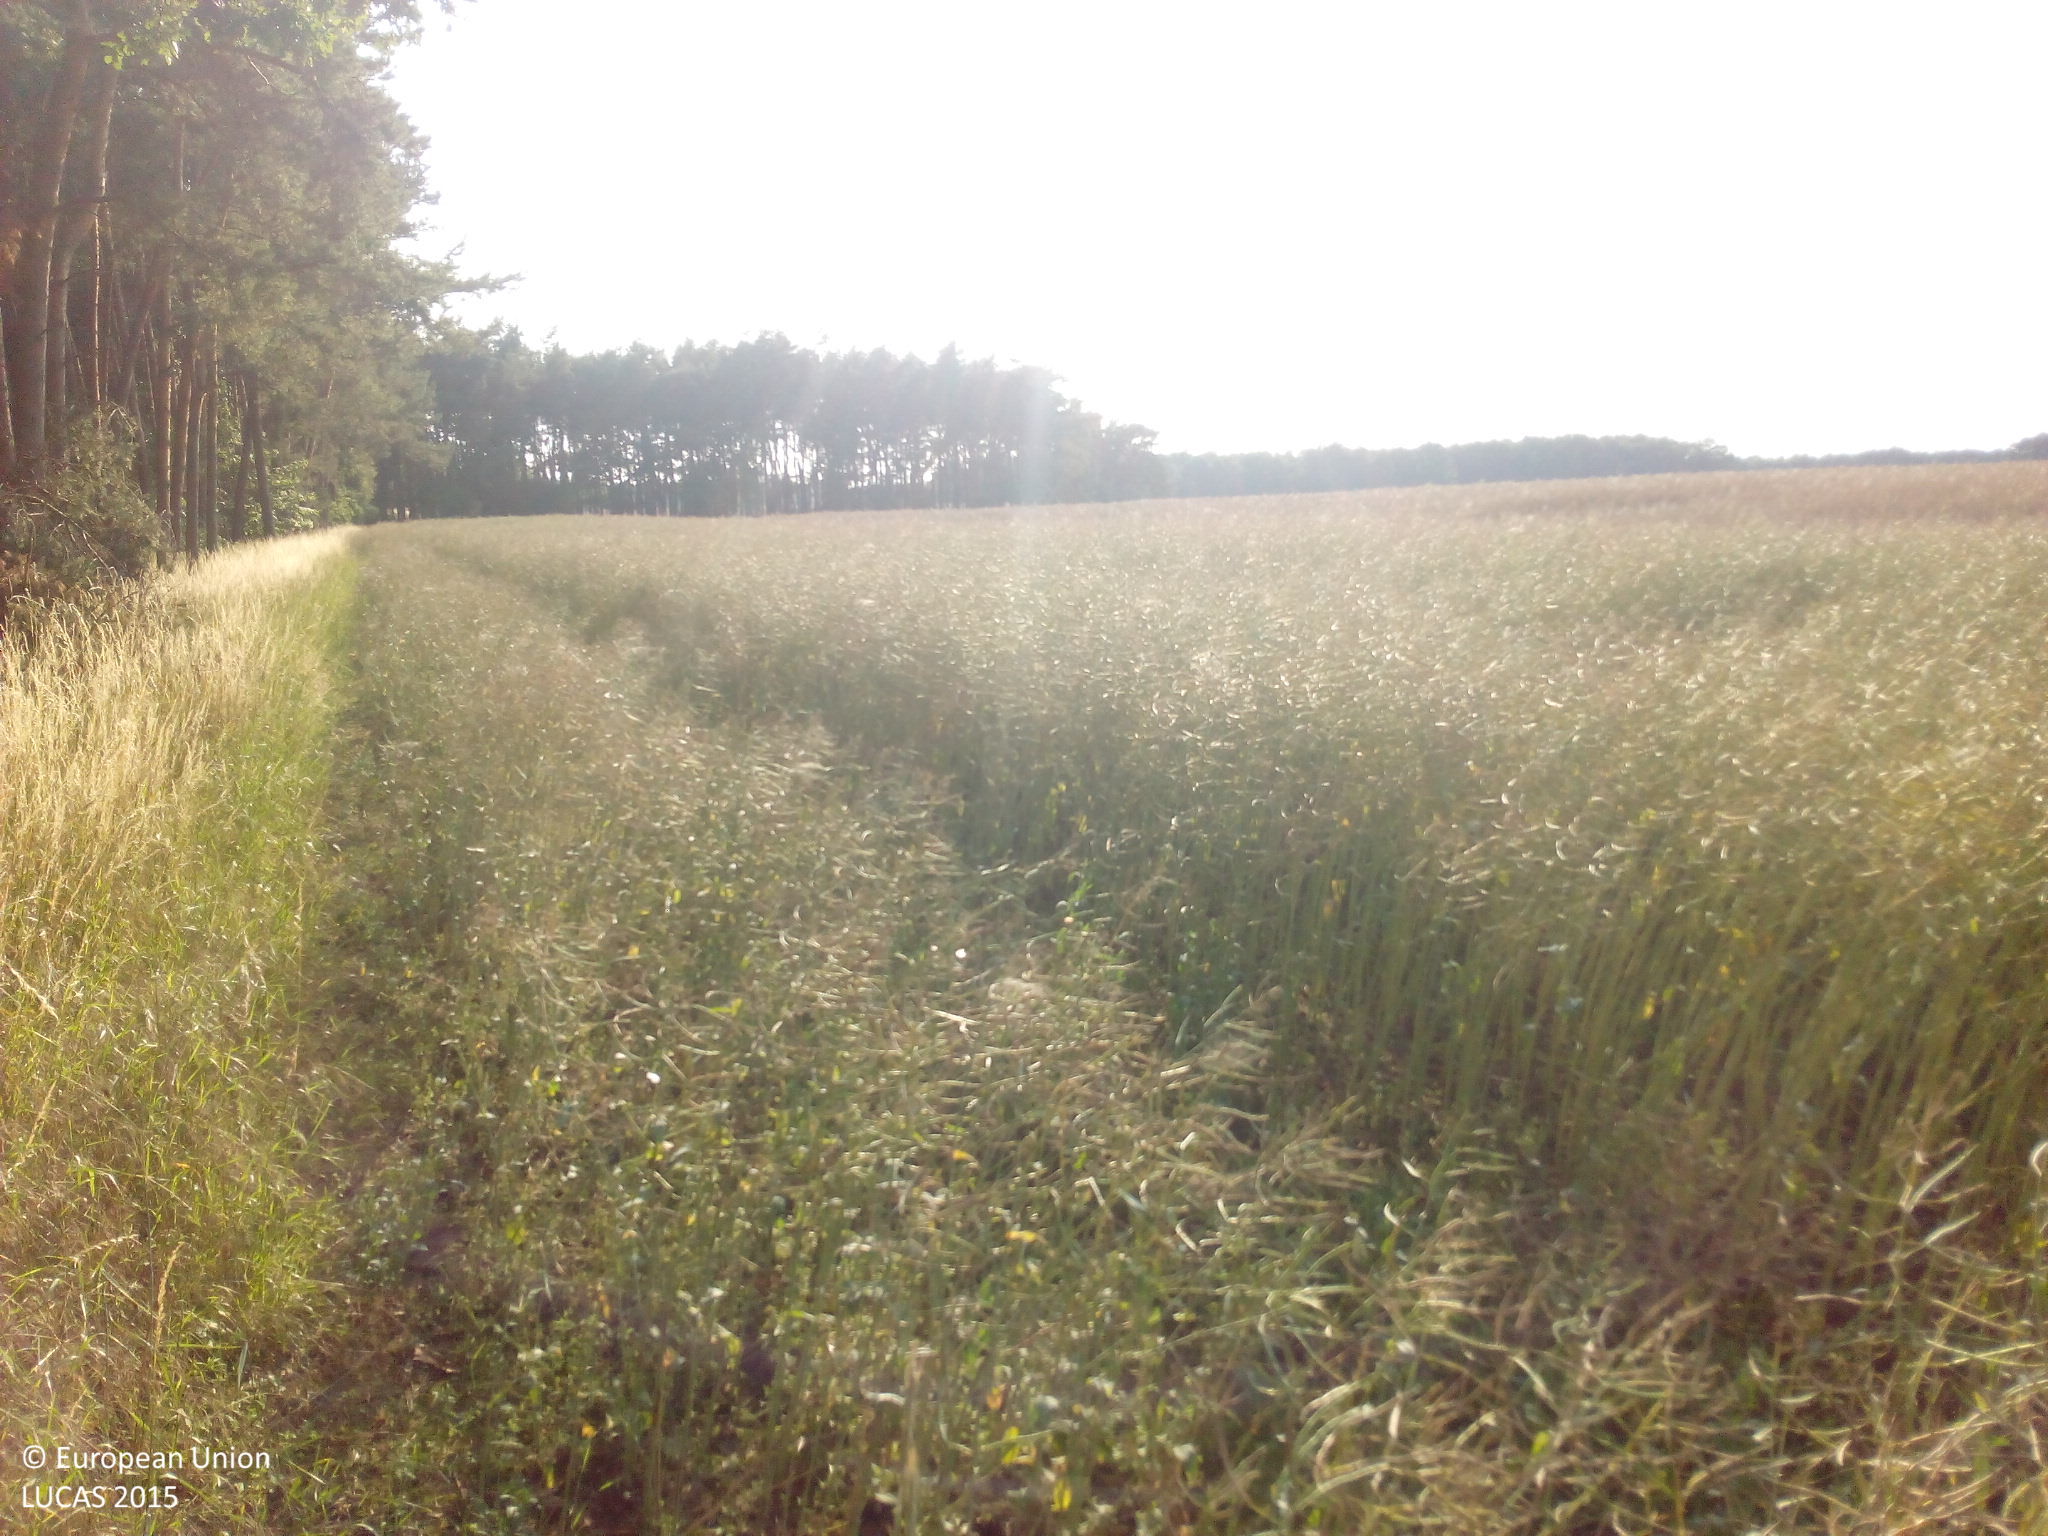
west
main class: Cropland
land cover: Rape and turnip rape
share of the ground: > 75 %
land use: Agriculture (excluding fallow land and kitchen gardens)
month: July
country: DE
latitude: 52.7318
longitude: 12.3541
